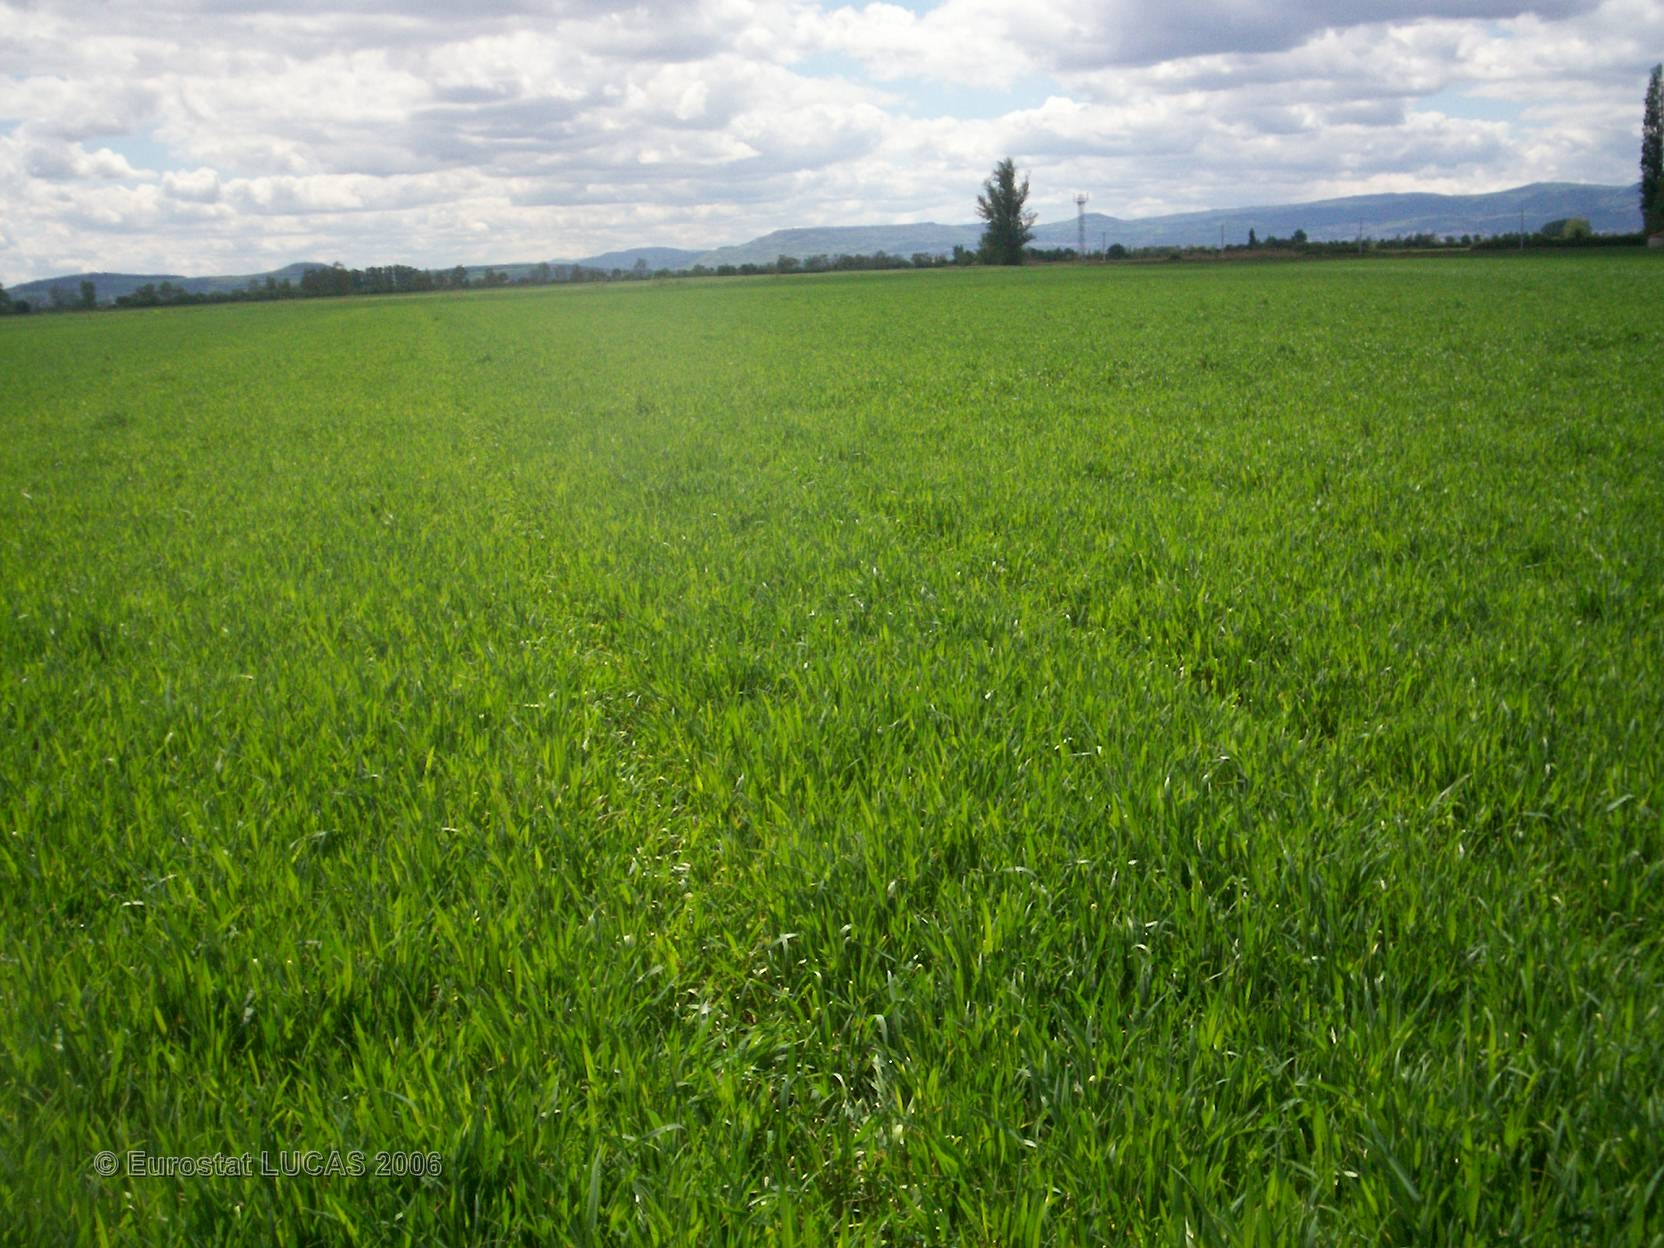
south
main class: Cropland
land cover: Triticale
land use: Agriculture (excluding fallow land and kitchen gardens)
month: May
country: FR
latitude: 45.8448
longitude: 3.1882
